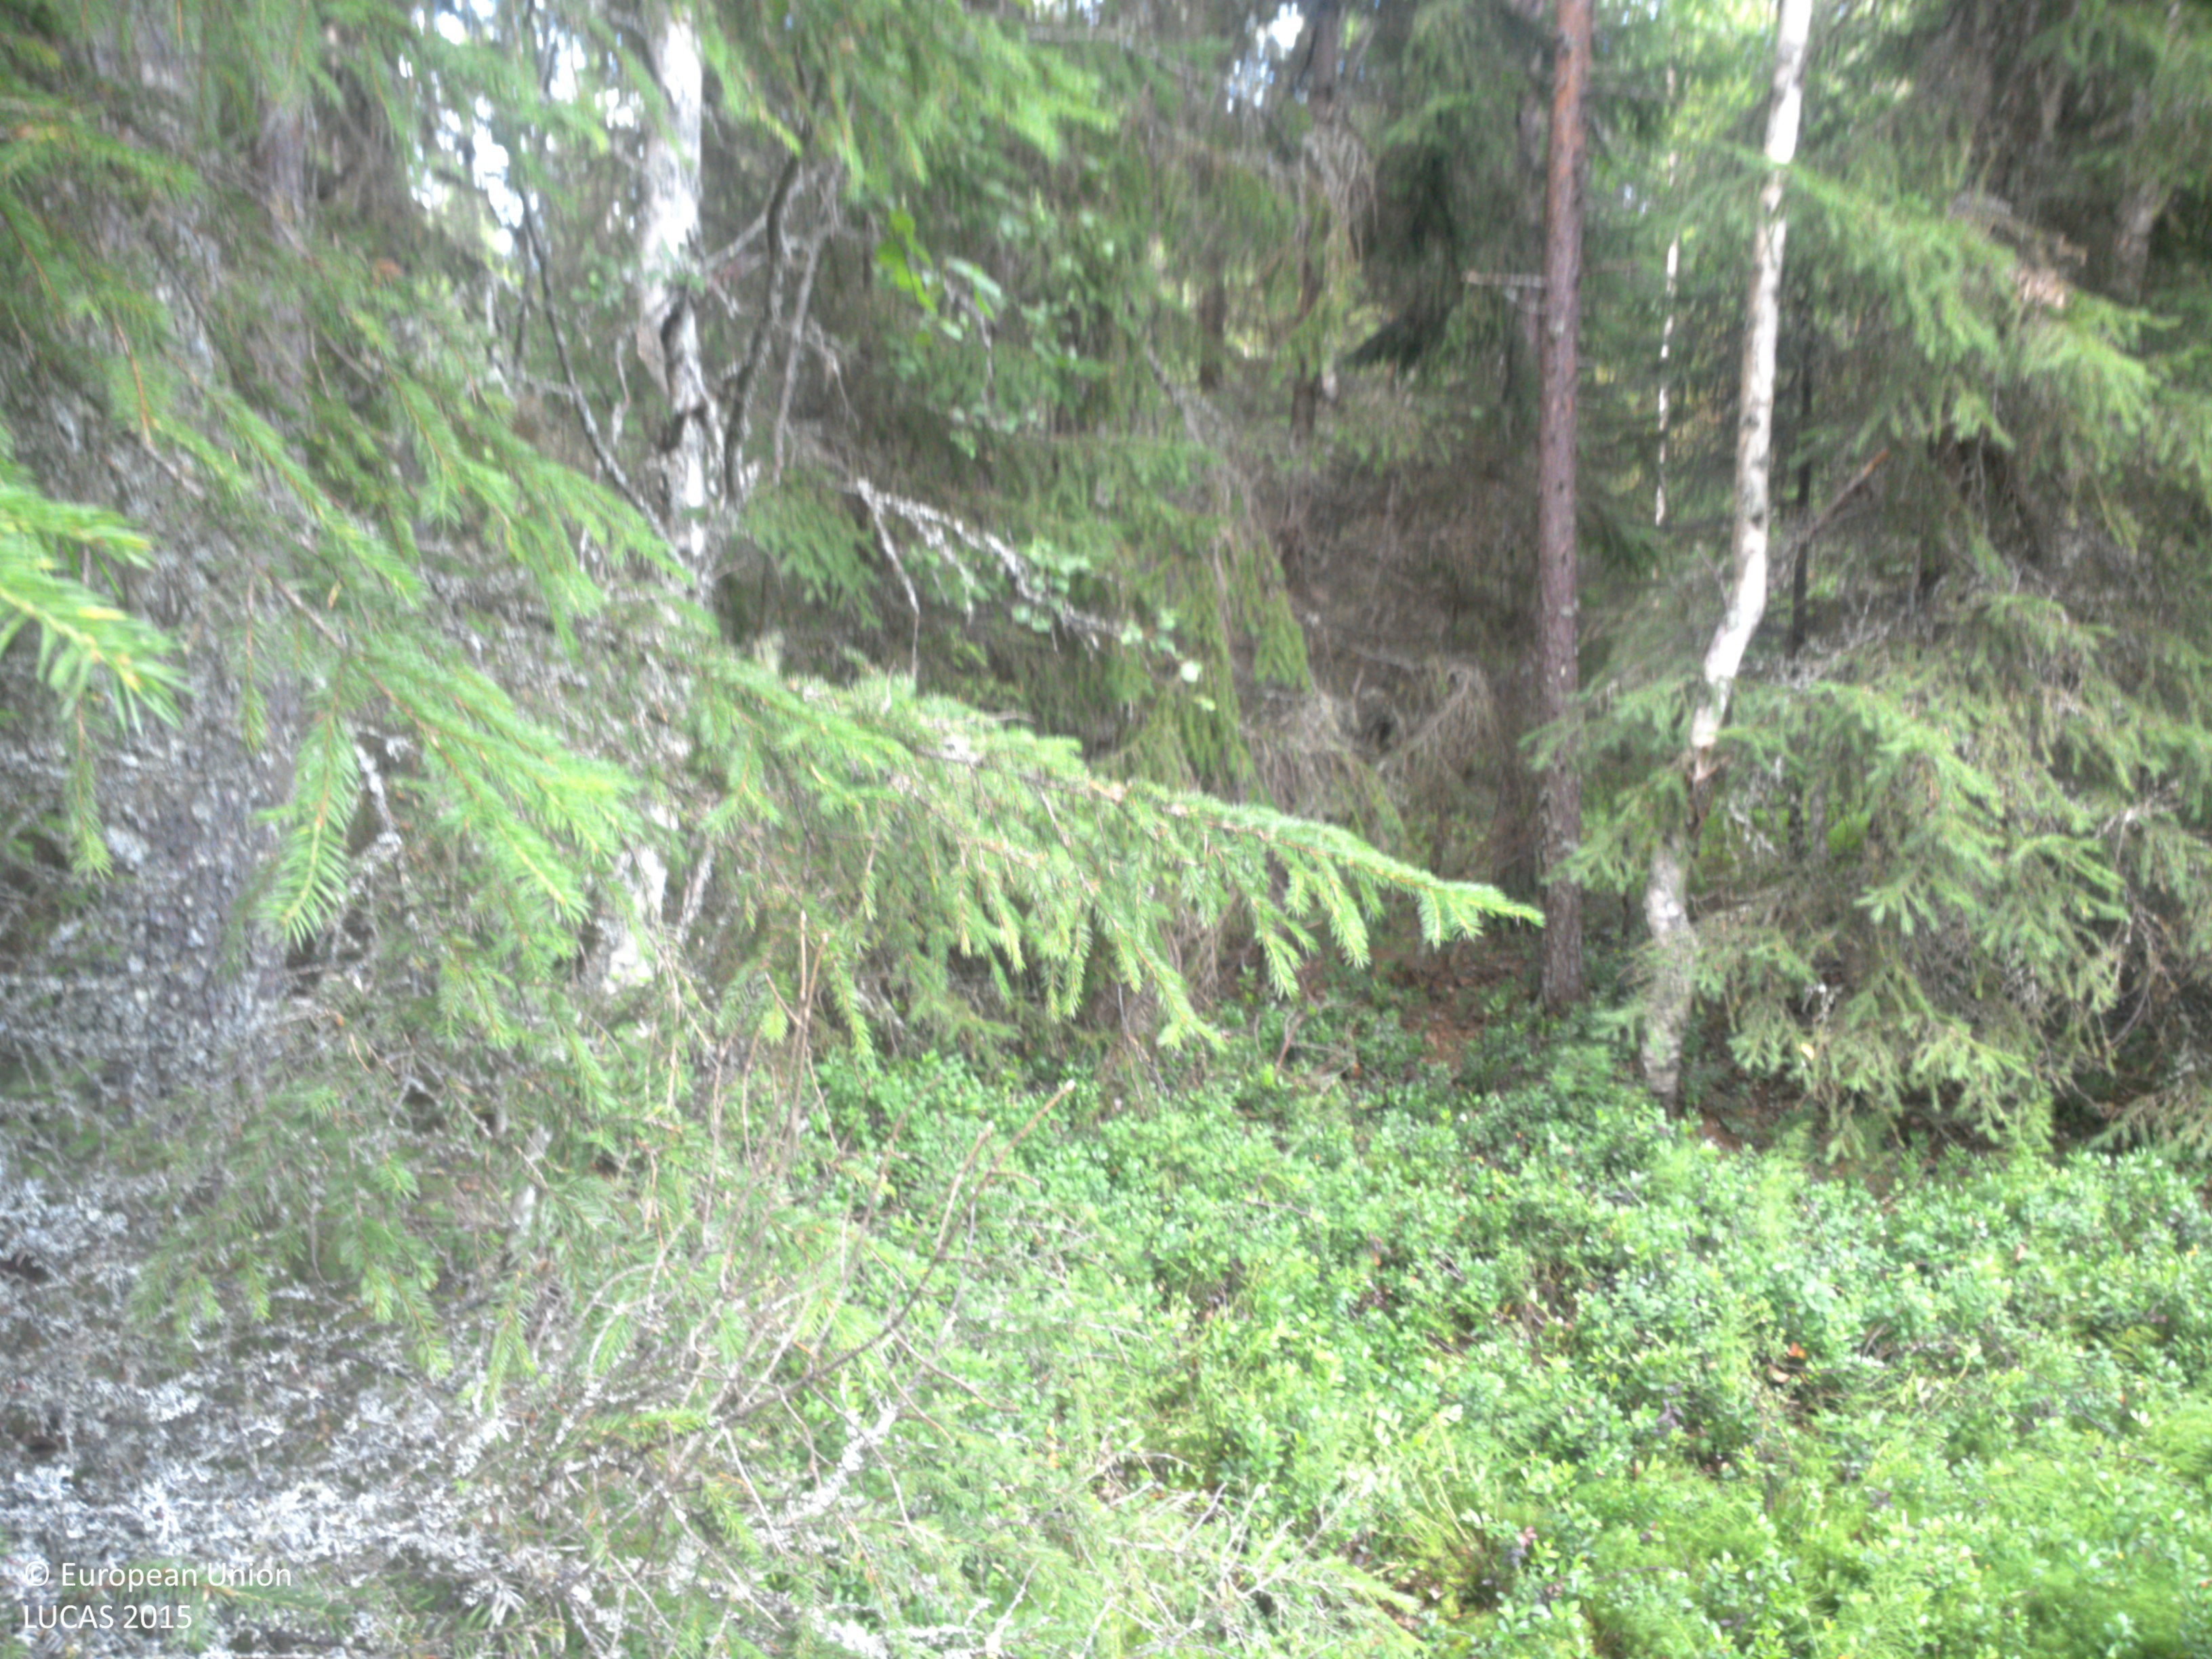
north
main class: Woodland
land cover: Other mixed woodland
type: boreal forest
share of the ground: 50 - 75 %
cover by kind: coniferous forest trees 40 %, broadleaved forest trees 20 %, shrubs 20 %, herbaceous plants 20 %
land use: Forestry
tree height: > 5 m
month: July
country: SE
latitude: 63.4822
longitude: 19.3950
